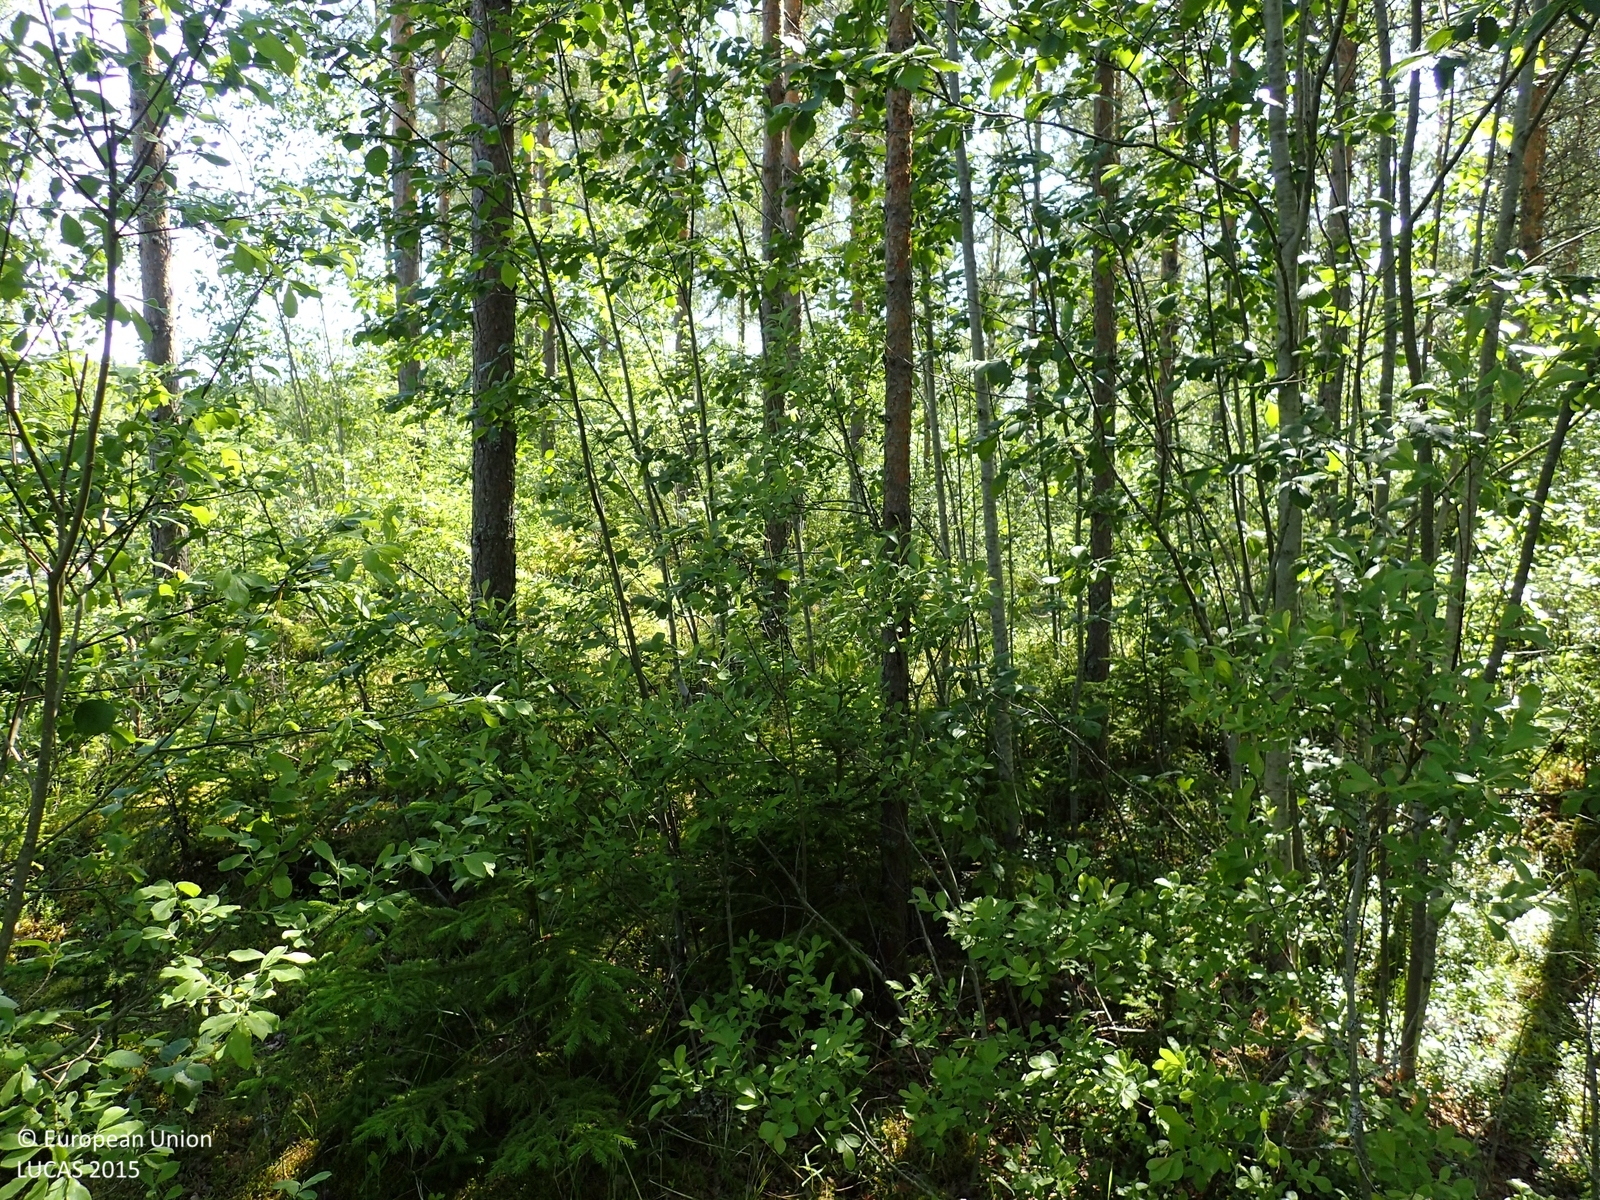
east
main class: Woodland
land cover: Pine dominated mixed woodland
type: boreal forest
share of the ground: > 75 %
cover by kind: coniferous forest trees 55 %, broadleaved forest trees 20 %, shrubs 20 %, lichens and mosses 5 %
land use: Forestry
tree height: > 5 m
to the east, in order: Pine dominated mixed woodland; Broadleaved woodland; Ditches and canals; Broadleaved woodland; Ditches and canals; Broadleaved woodland; Pine dominated coniferous woodland
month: July
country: FI
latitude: 62.8229
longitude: 21.5614
